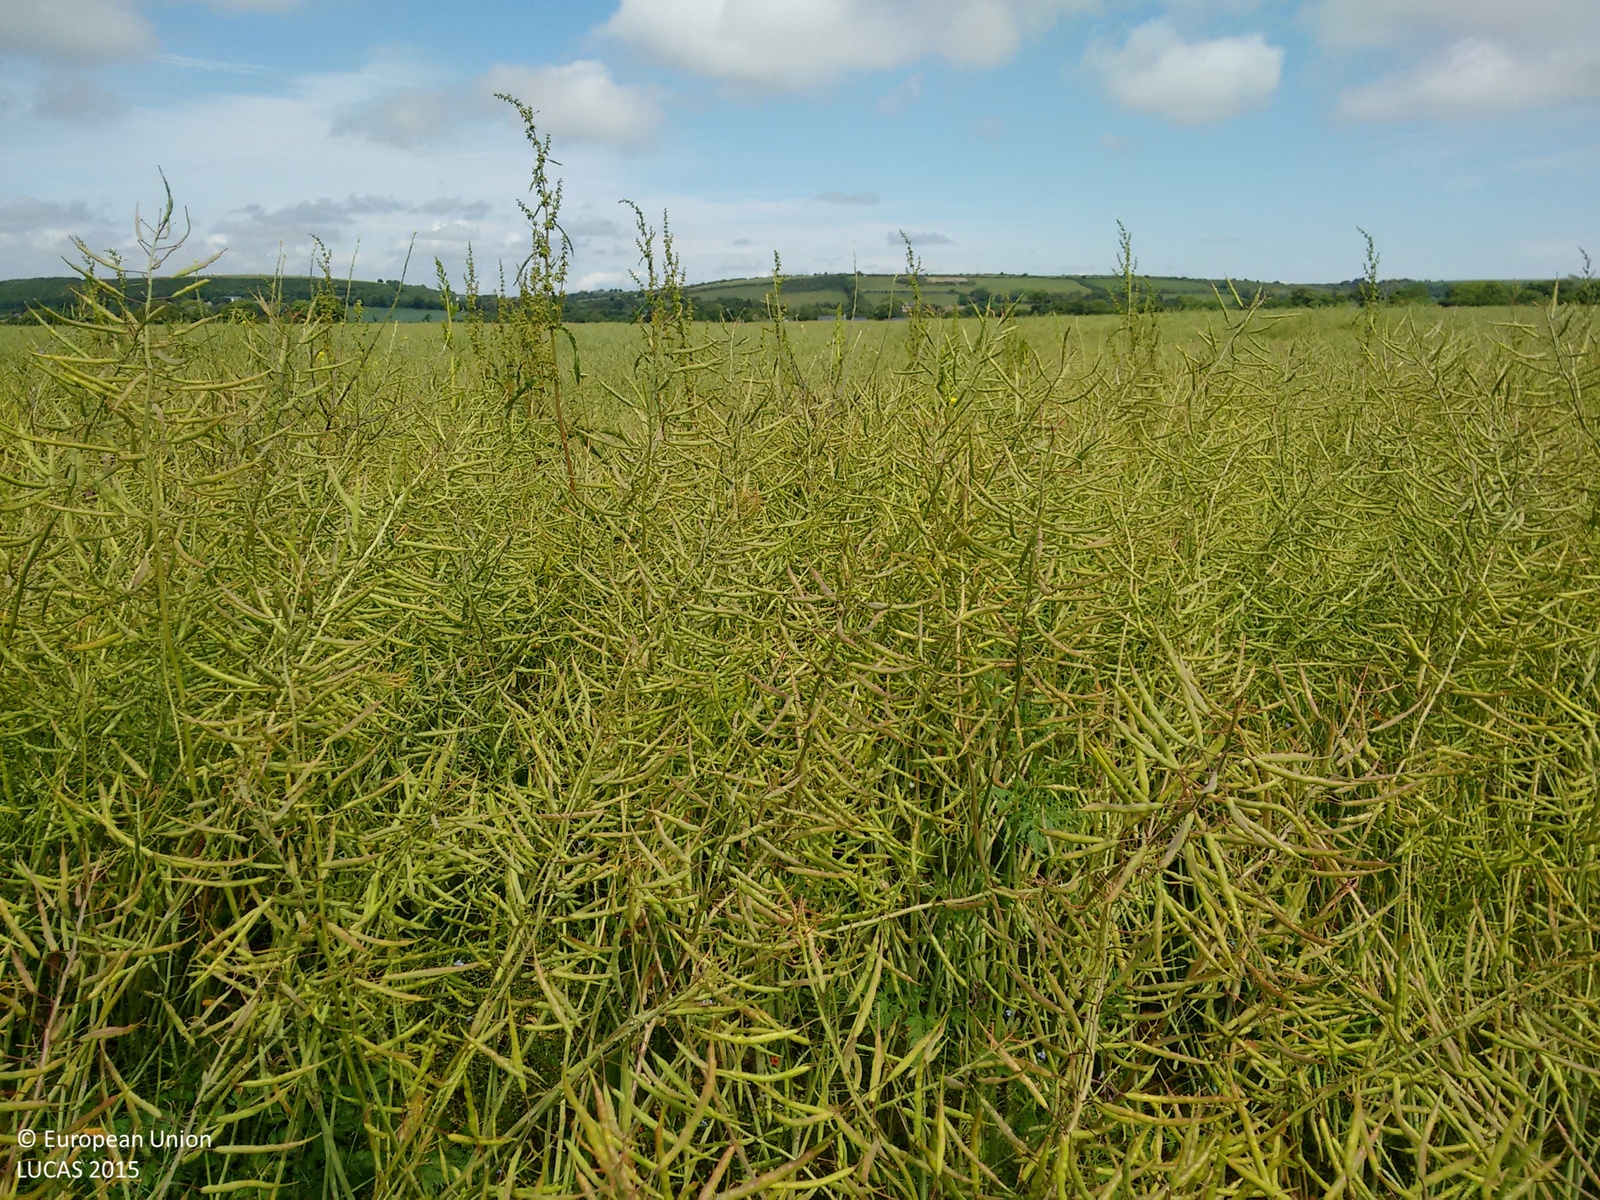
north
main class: Cropland
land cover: Rape and turnip rape
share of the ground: > 75 %
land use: Agriculture (excluding fallow land and kitchen gardens)
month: June
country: IE
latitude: 51.8573
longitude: -8.0816
